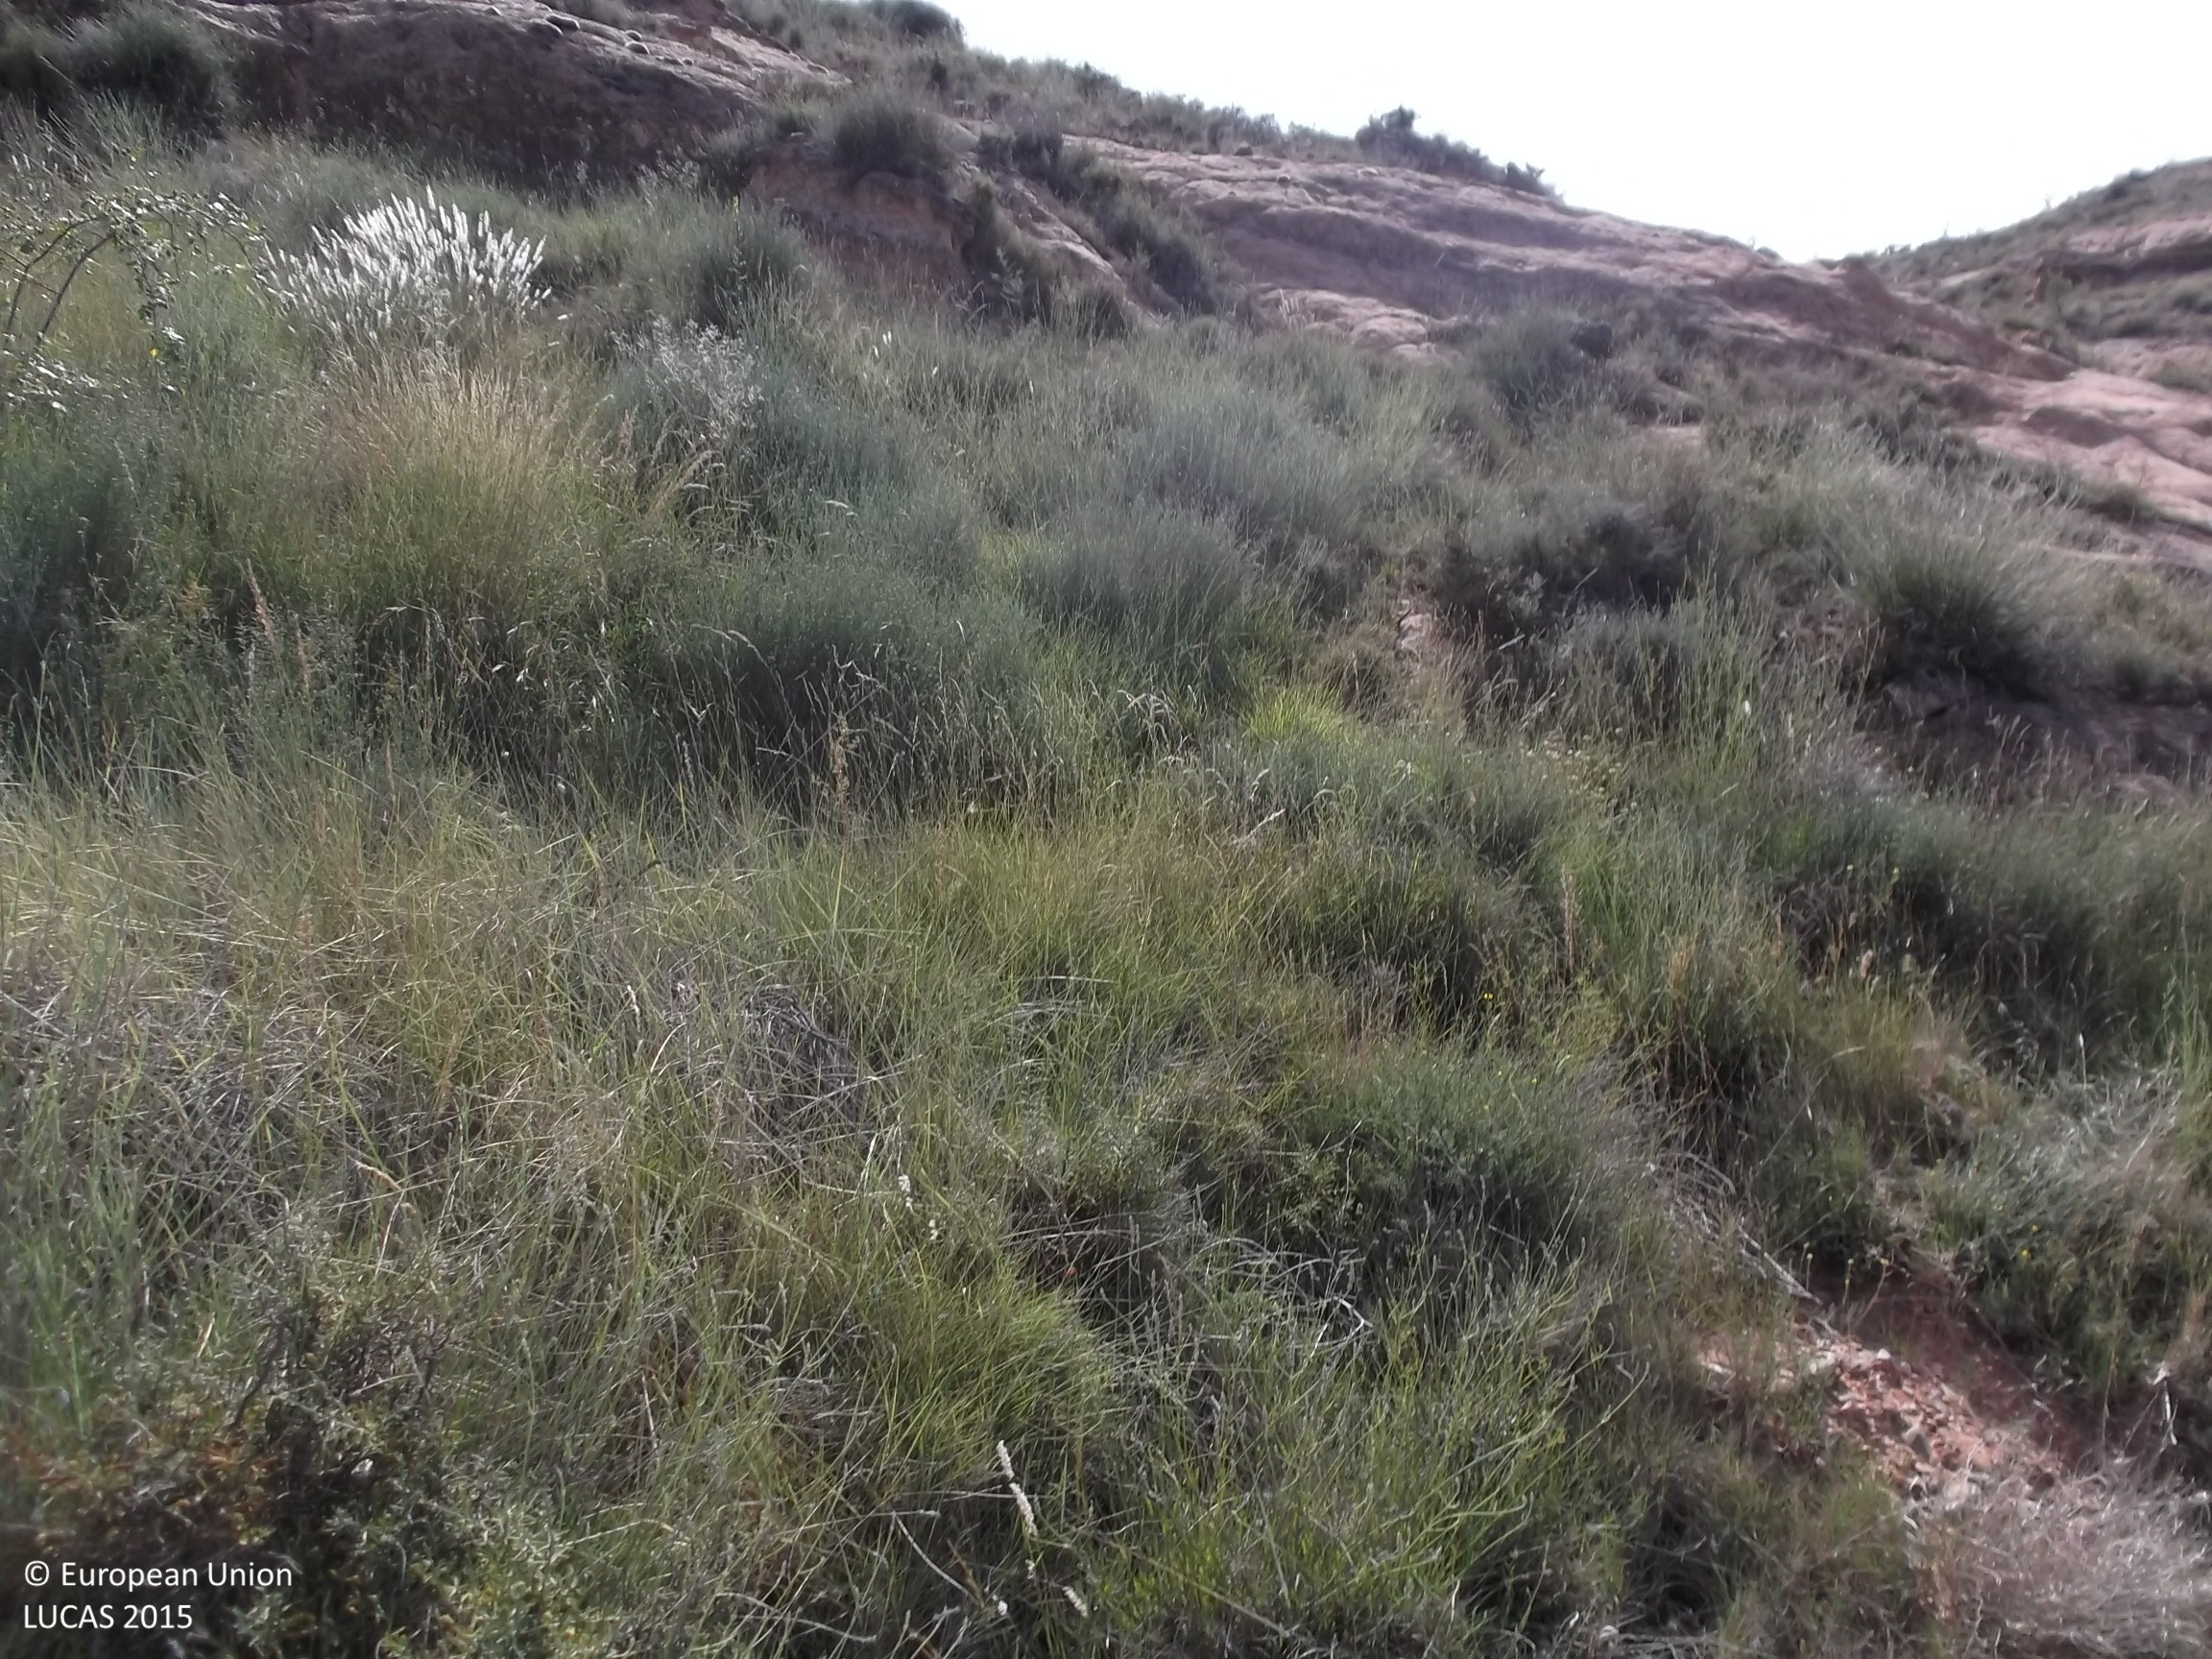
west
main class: Shrubland
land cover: Shrubland without tree cover
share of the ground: 50 - 75 %
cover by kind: shrubs 60 %, herbaceous plants 30 %, unconsolidated bare surface 10 %
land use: Semi-natural and natural areas not in use
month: June
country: ES
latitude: 42.2364
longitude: -2.0957
